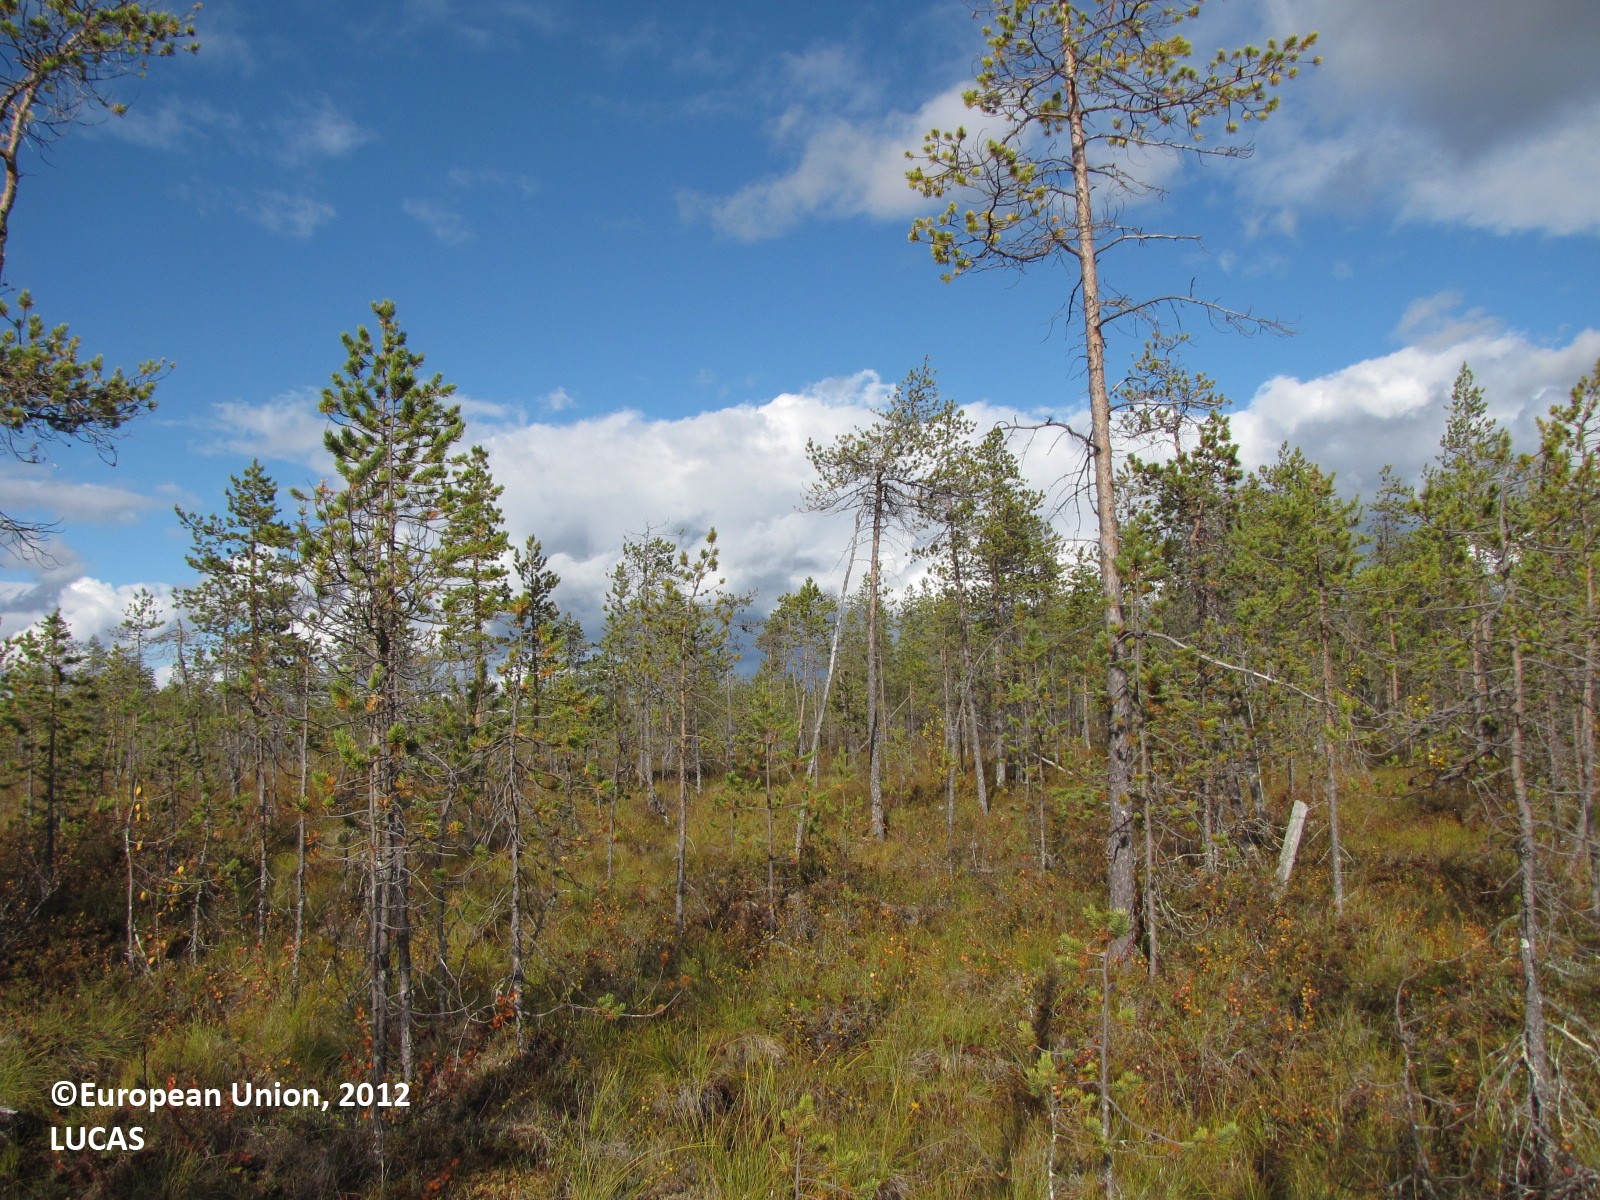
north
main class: Woodland
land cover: Pine dominated coniferous woodland
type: boreal forest
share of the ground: 25 - 50 %
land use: Forestry
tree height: > 5 m
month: September
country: FI
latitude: 67.3882
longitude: 24.8854
